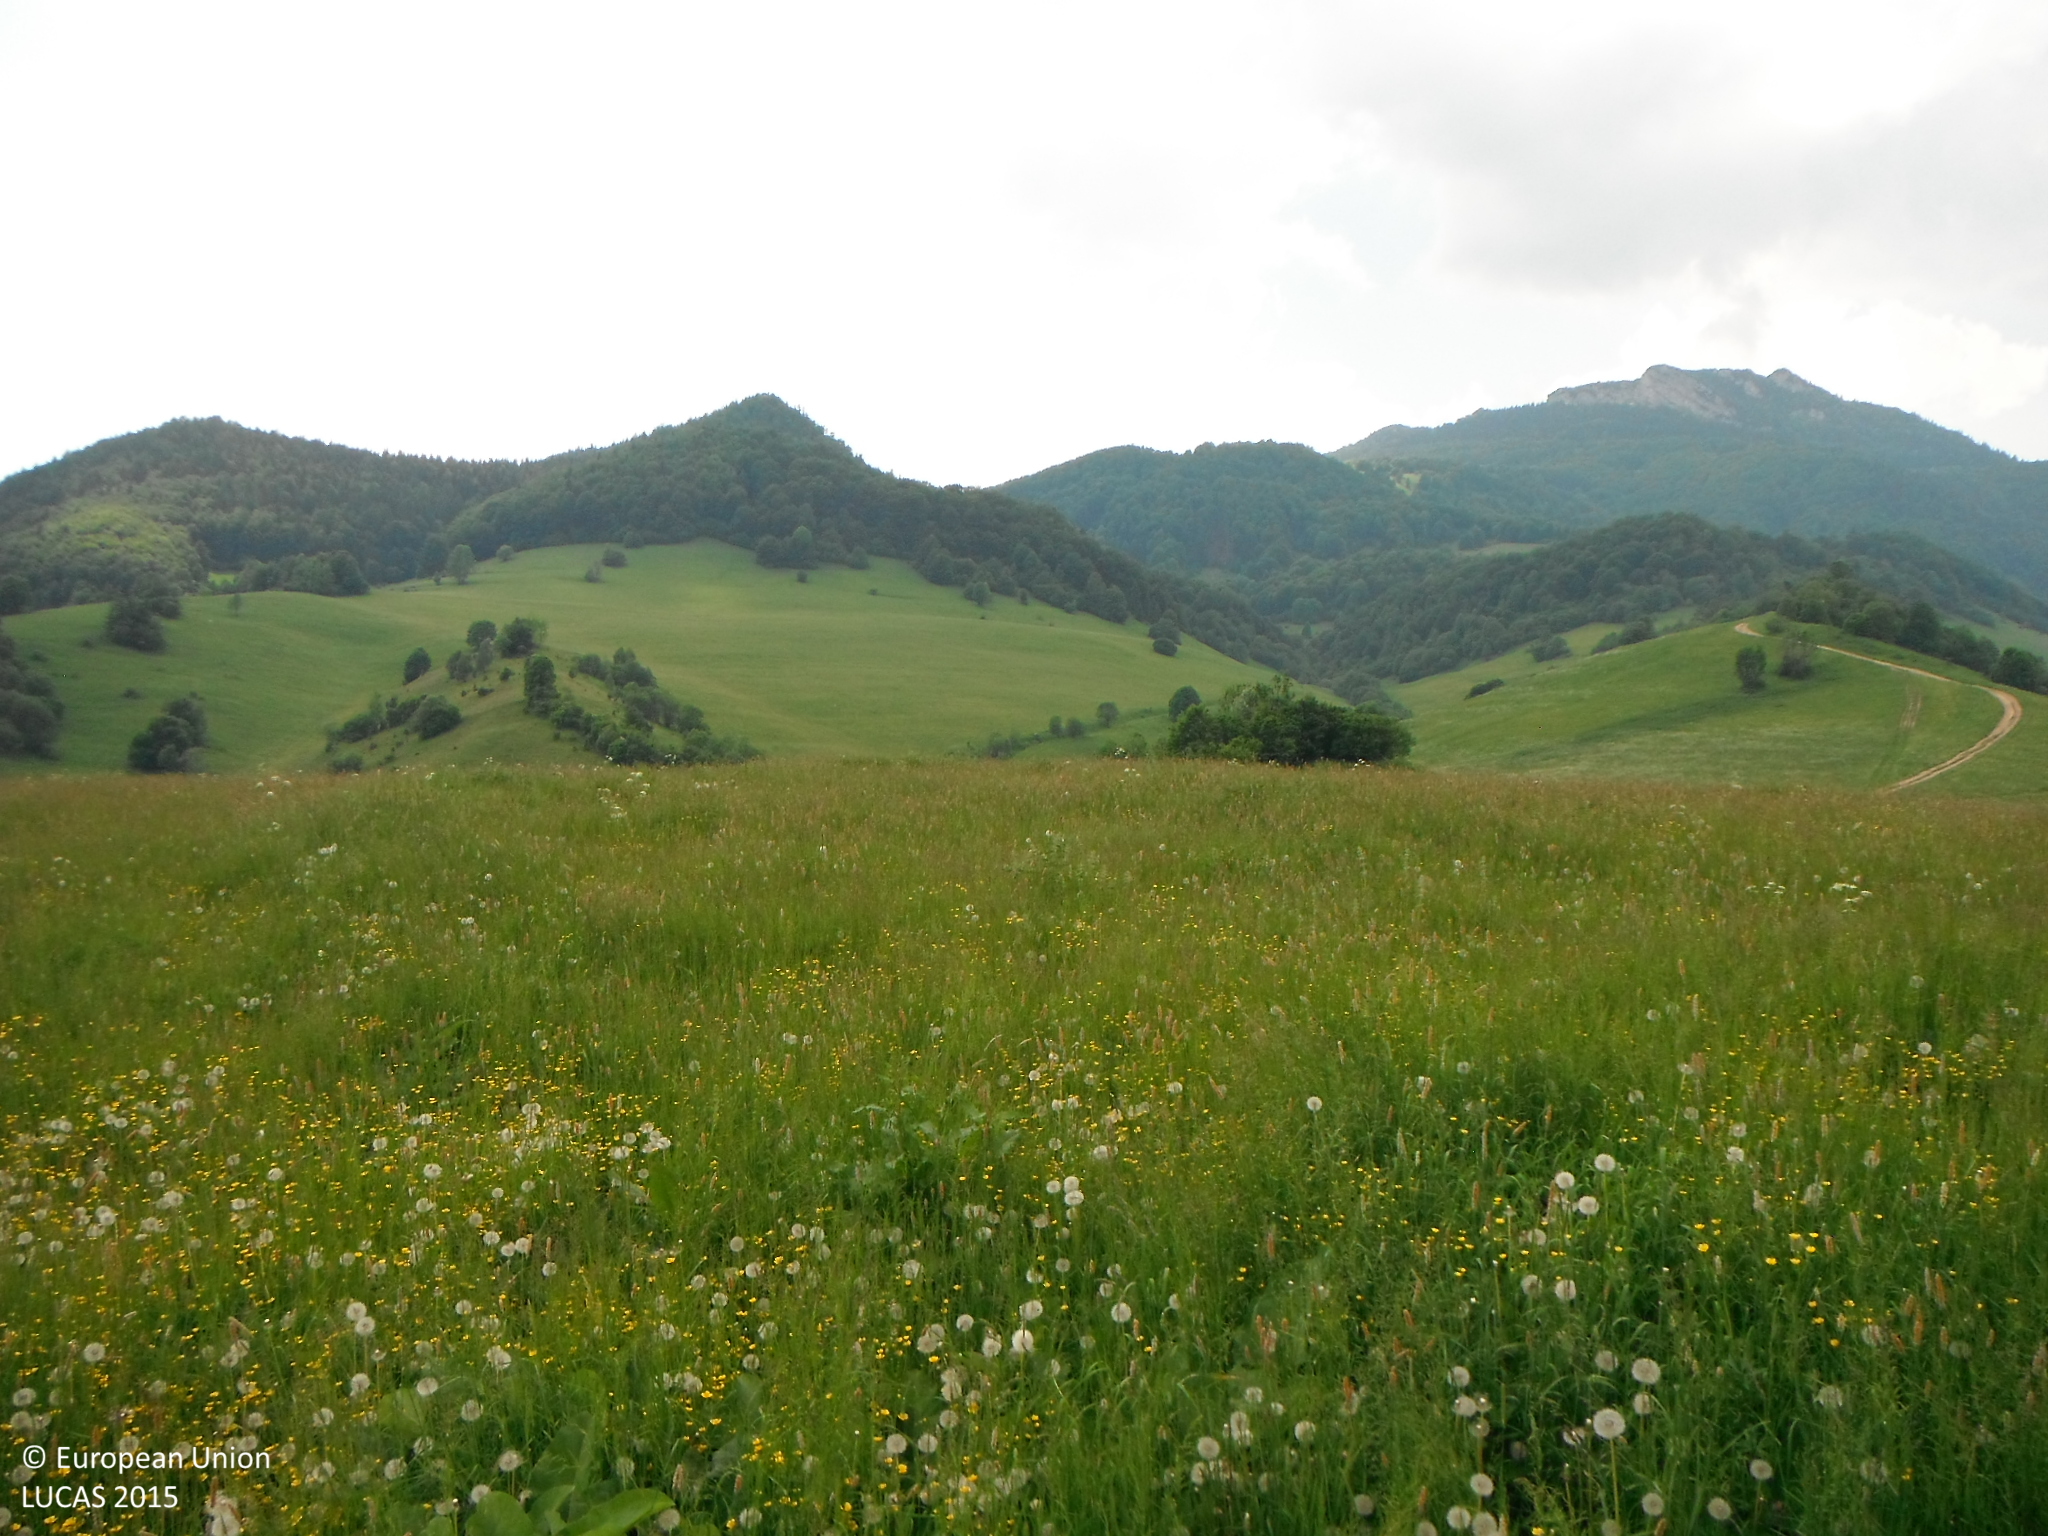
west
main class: Grassland
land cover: Grassland without tree/shrub cover
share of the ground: > 75 %
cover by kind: herbaceous plants 100 %
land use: Agriculture (excluding fallow land and kitchen gardens)
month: June
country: SK
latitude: 48.9261
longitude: 19.1812
